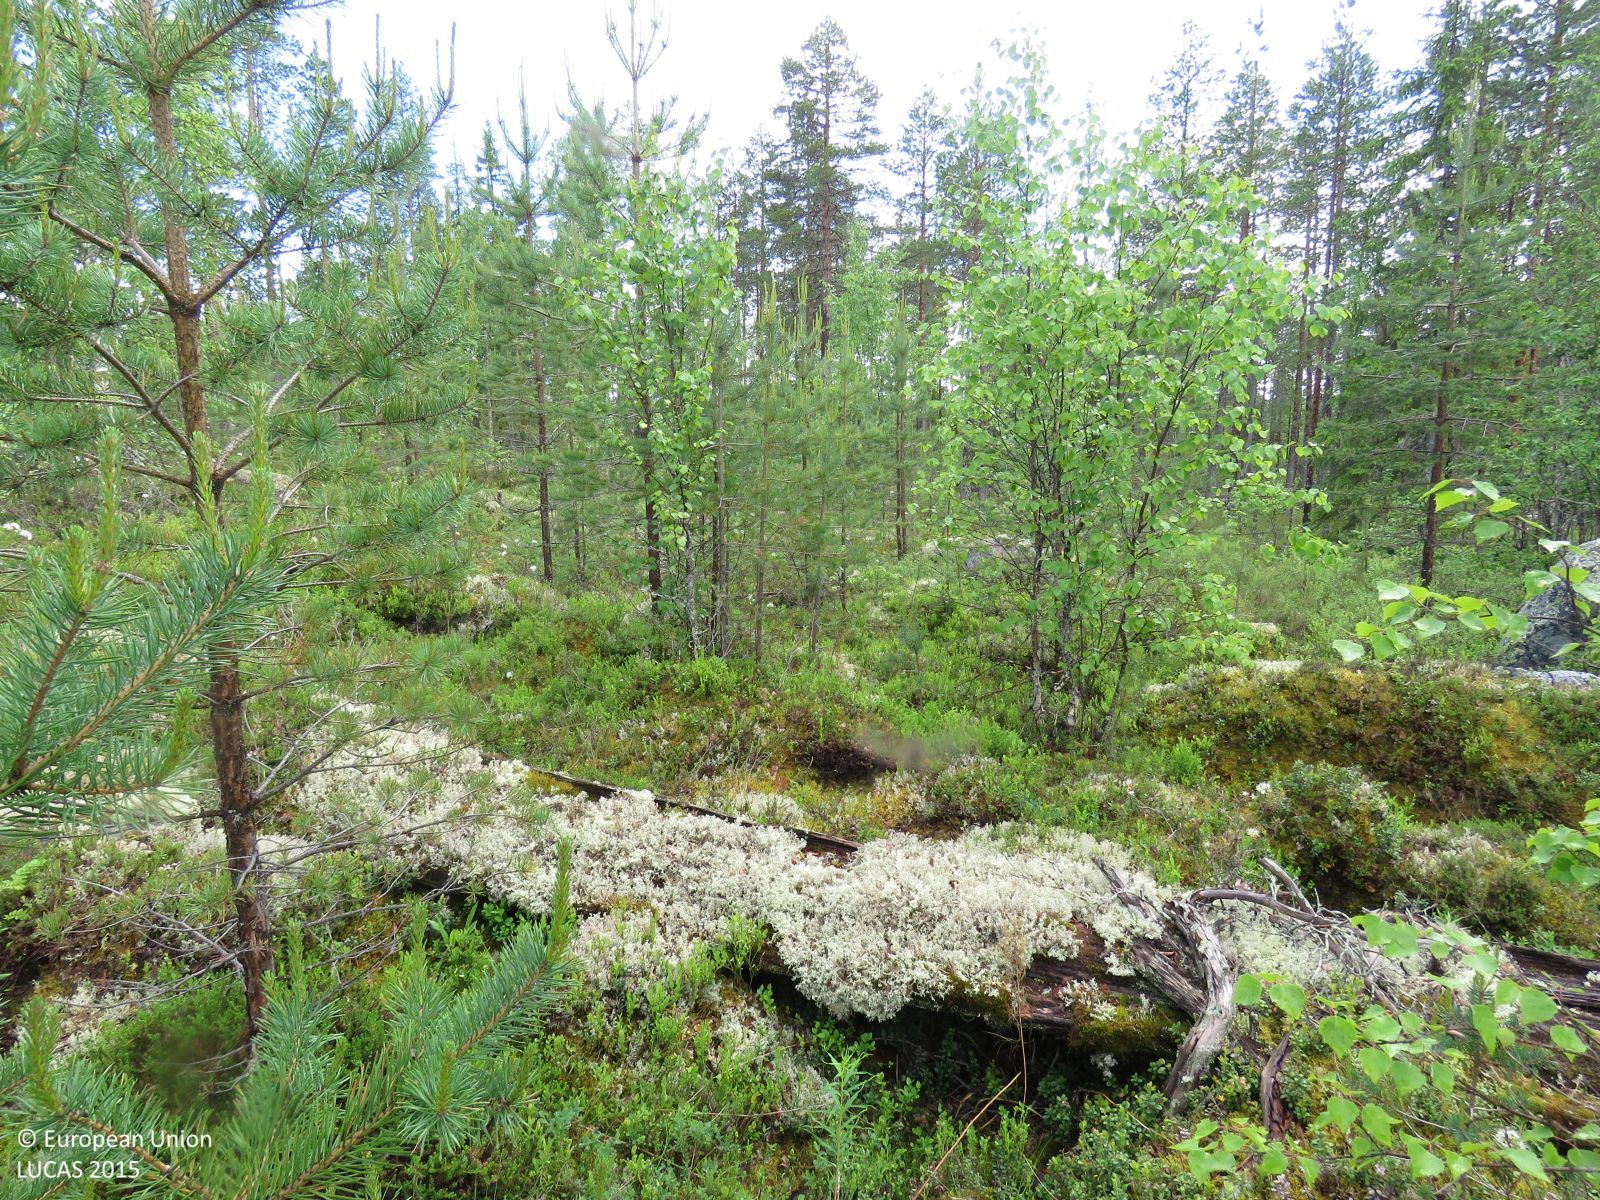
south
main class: Woodland
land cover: Pine dominated mixed woodland
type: boreal forest
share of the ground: 50 - 75 %
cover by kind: shrubs 35 %, broadleaved forest trees 30 %, coniferous forest trees 20 %, lichens and mosses 10 %, herbaceous plants 5 %
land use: Forestry
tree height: < 5 m
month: June
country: FI
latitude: 64.1295
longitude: 26.7434
